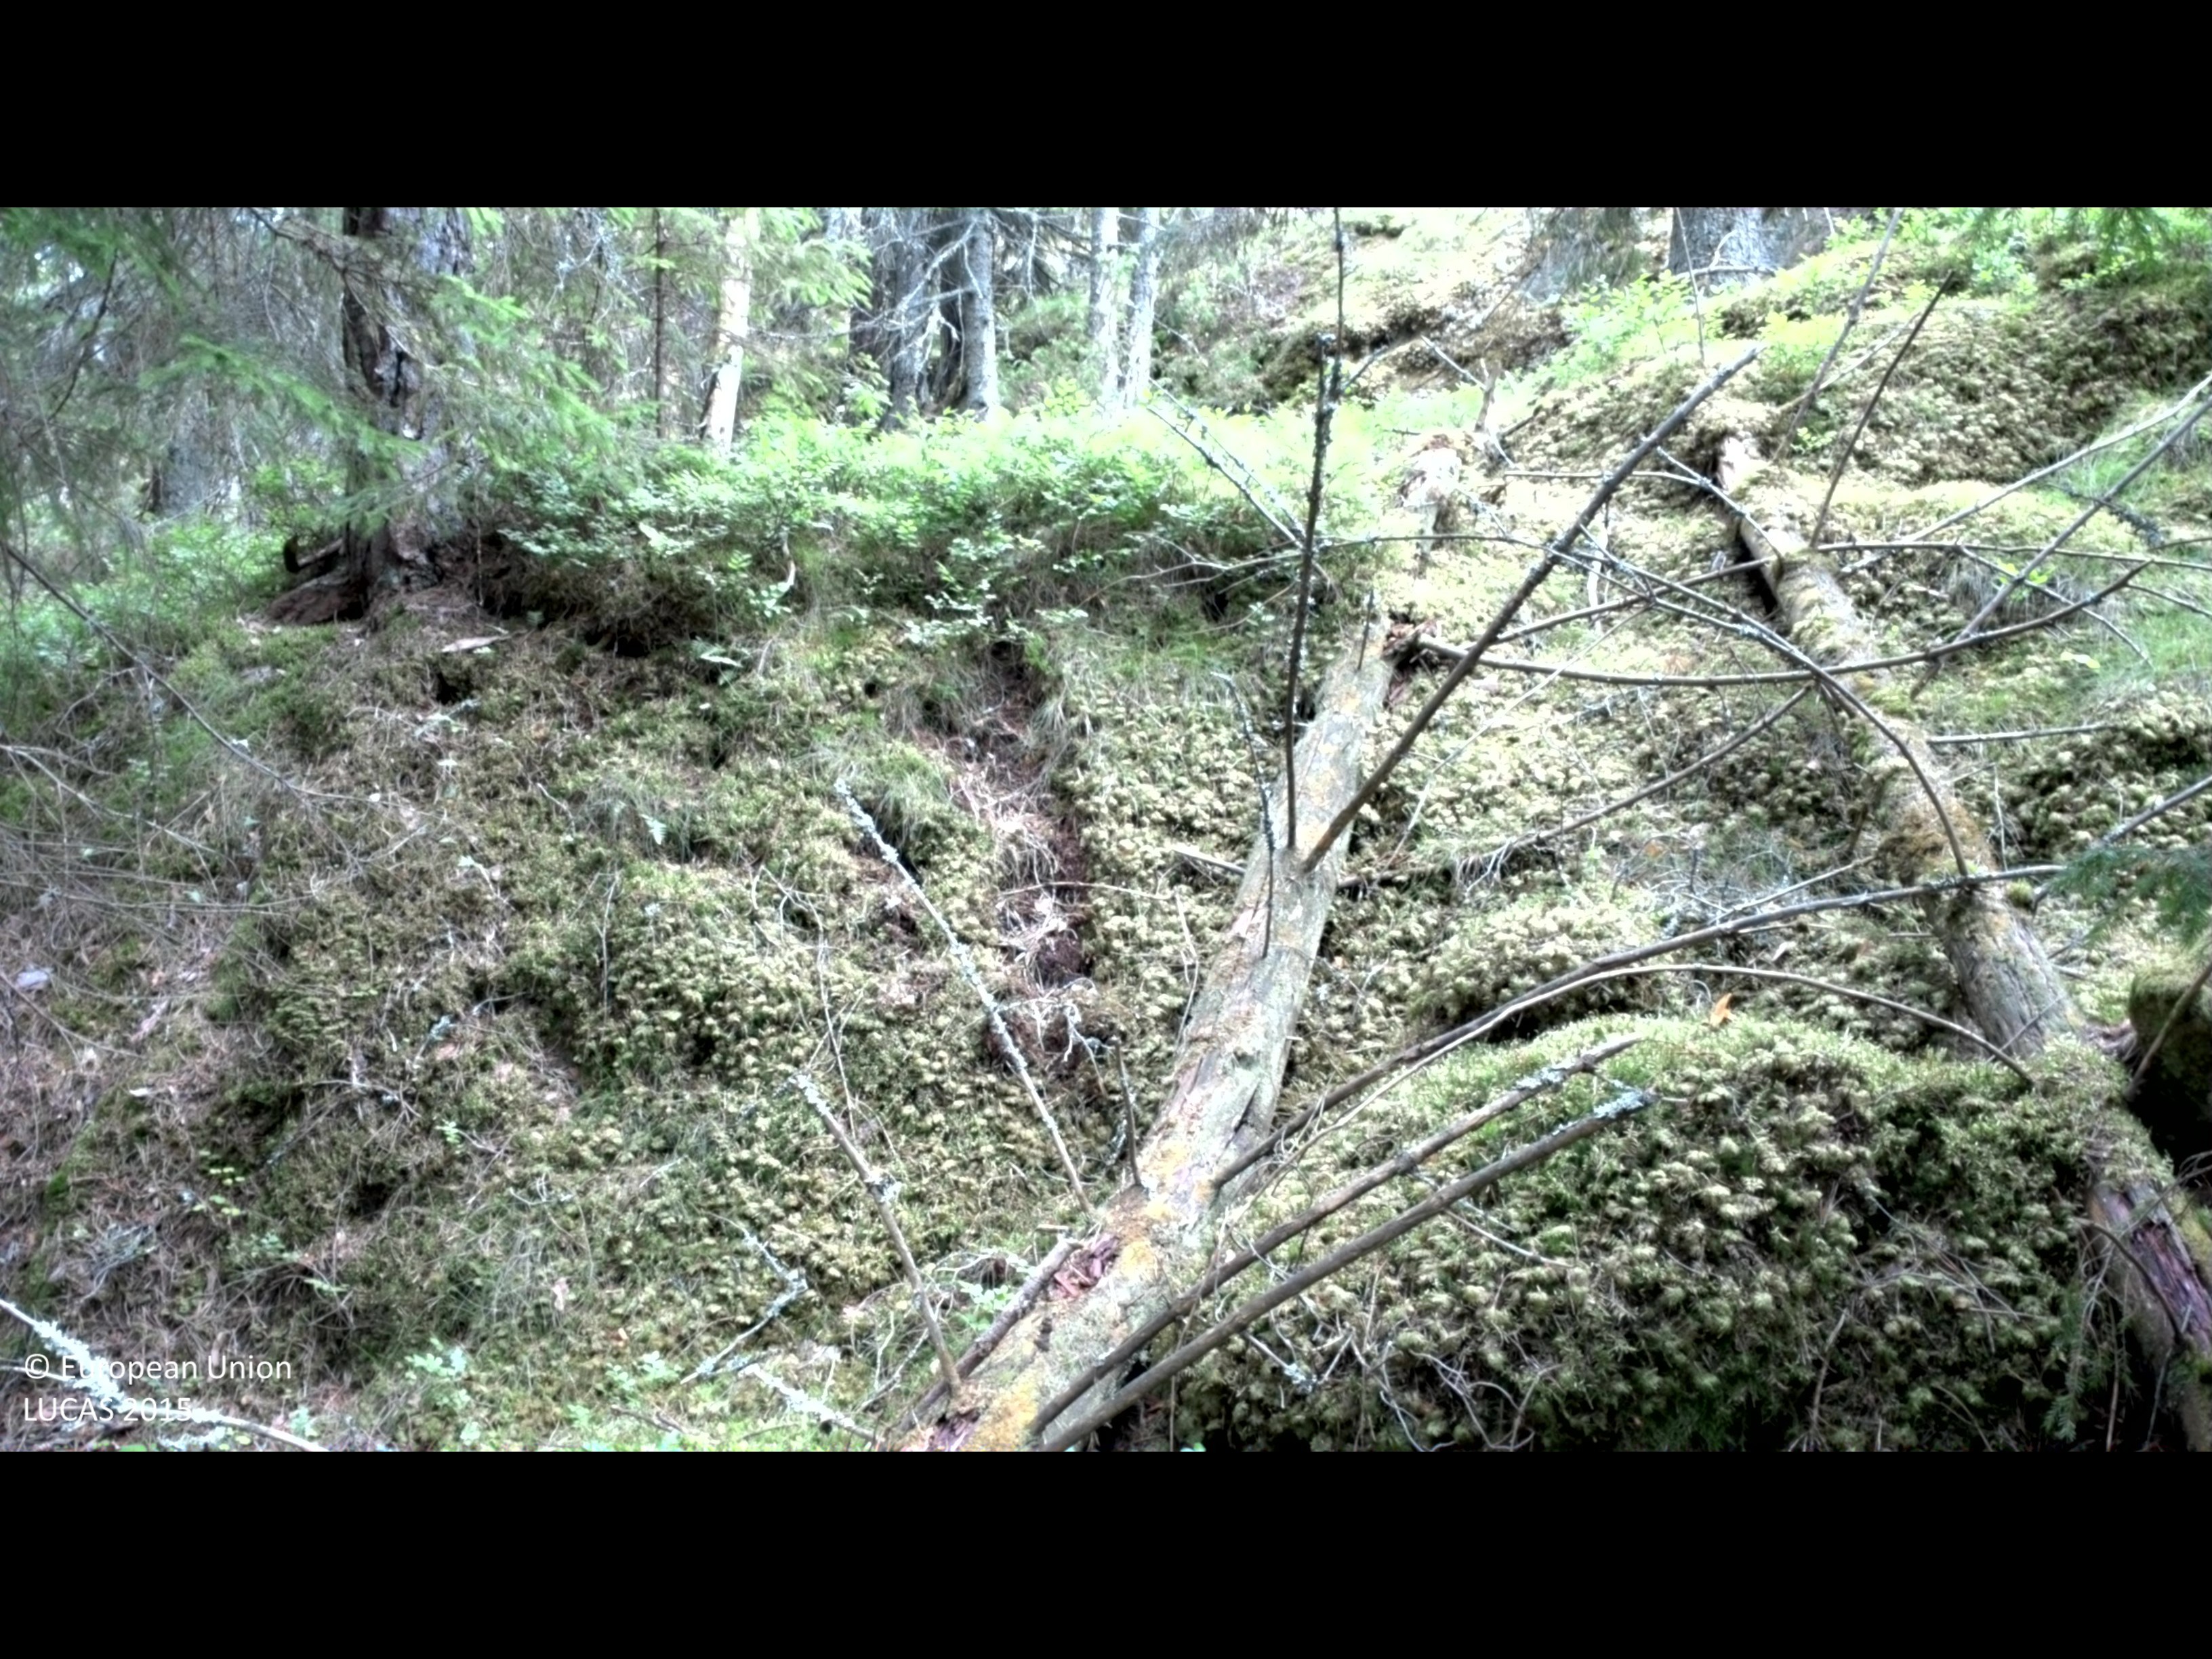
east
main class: Woodland
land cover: Spruce dominated coniferous woodland
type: boreal forest
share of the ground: 50 - 75 %
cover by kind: coniferous forest trees 65 %, shrubs 15 %, lichens and mosses 15 %, herbaceous plants 5 %
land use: Forestry
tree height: > 5 m
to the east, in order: Spruce dominated coniferous woodland; Pine dominated coniferous woodland; Spruce dominated coniferous woodland; Other coniferous woodland; Pine dominated coniferous woodland
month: June
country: SE
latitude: 58.0741
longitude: 16.6270
